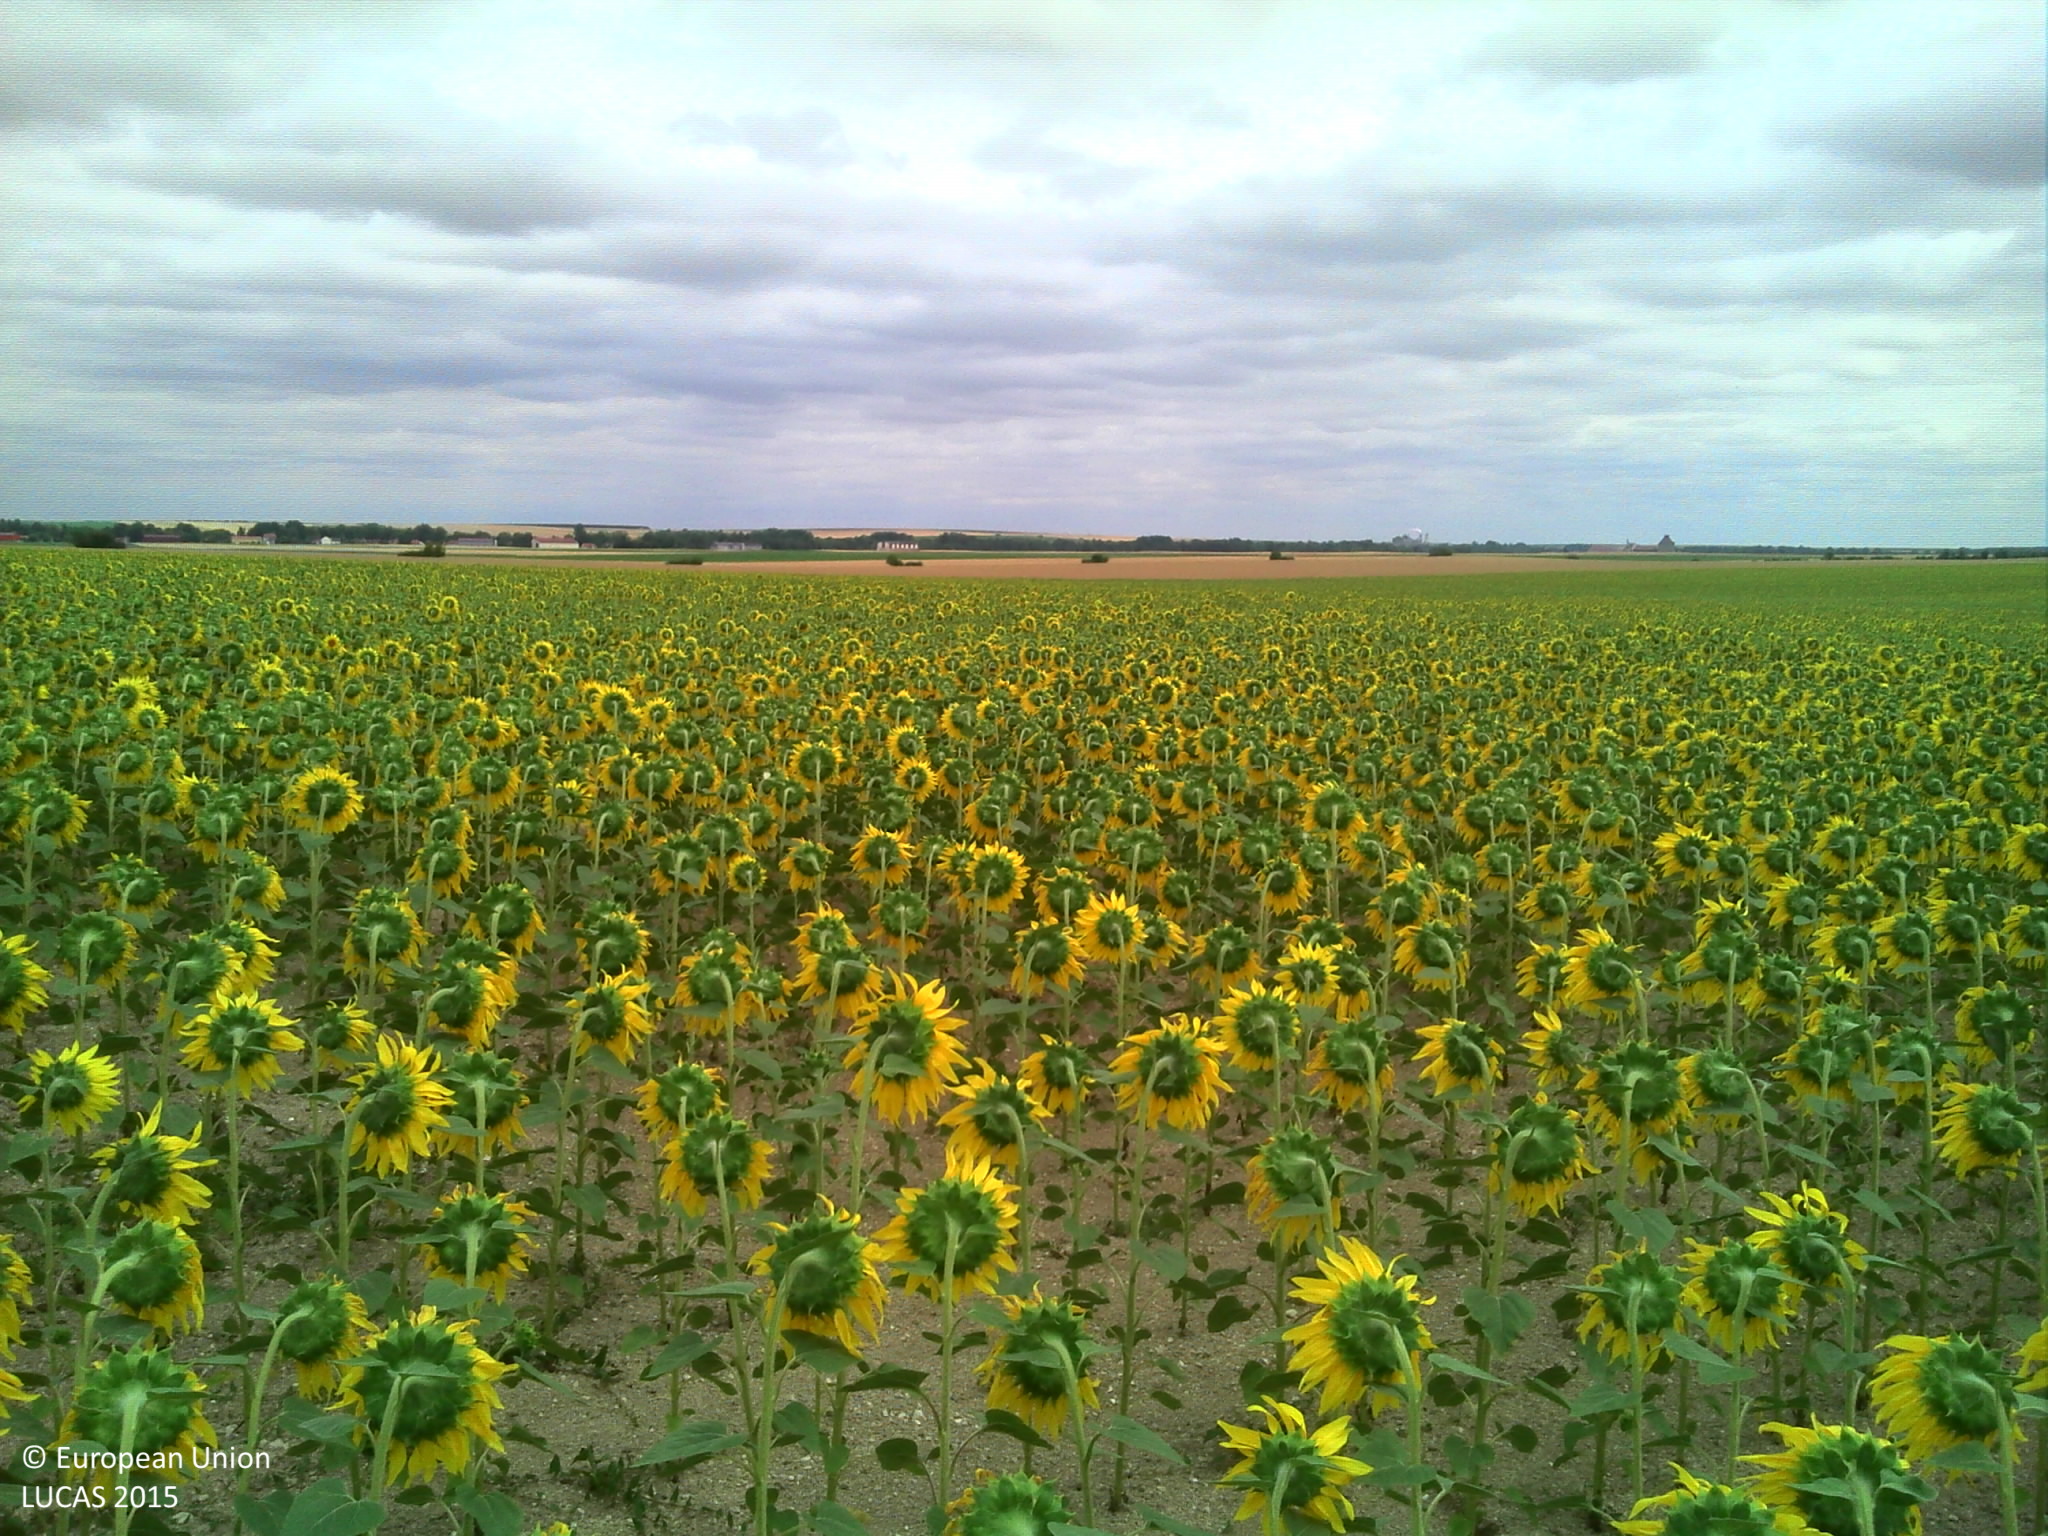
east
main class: Cropland
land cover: Sunflower
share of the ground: > 75 %
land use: Agriculture (excluding fallow land and kitchen gardens)
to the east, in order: Sunflower
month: July
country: FR
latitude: 48.8274
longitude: 4.1794
